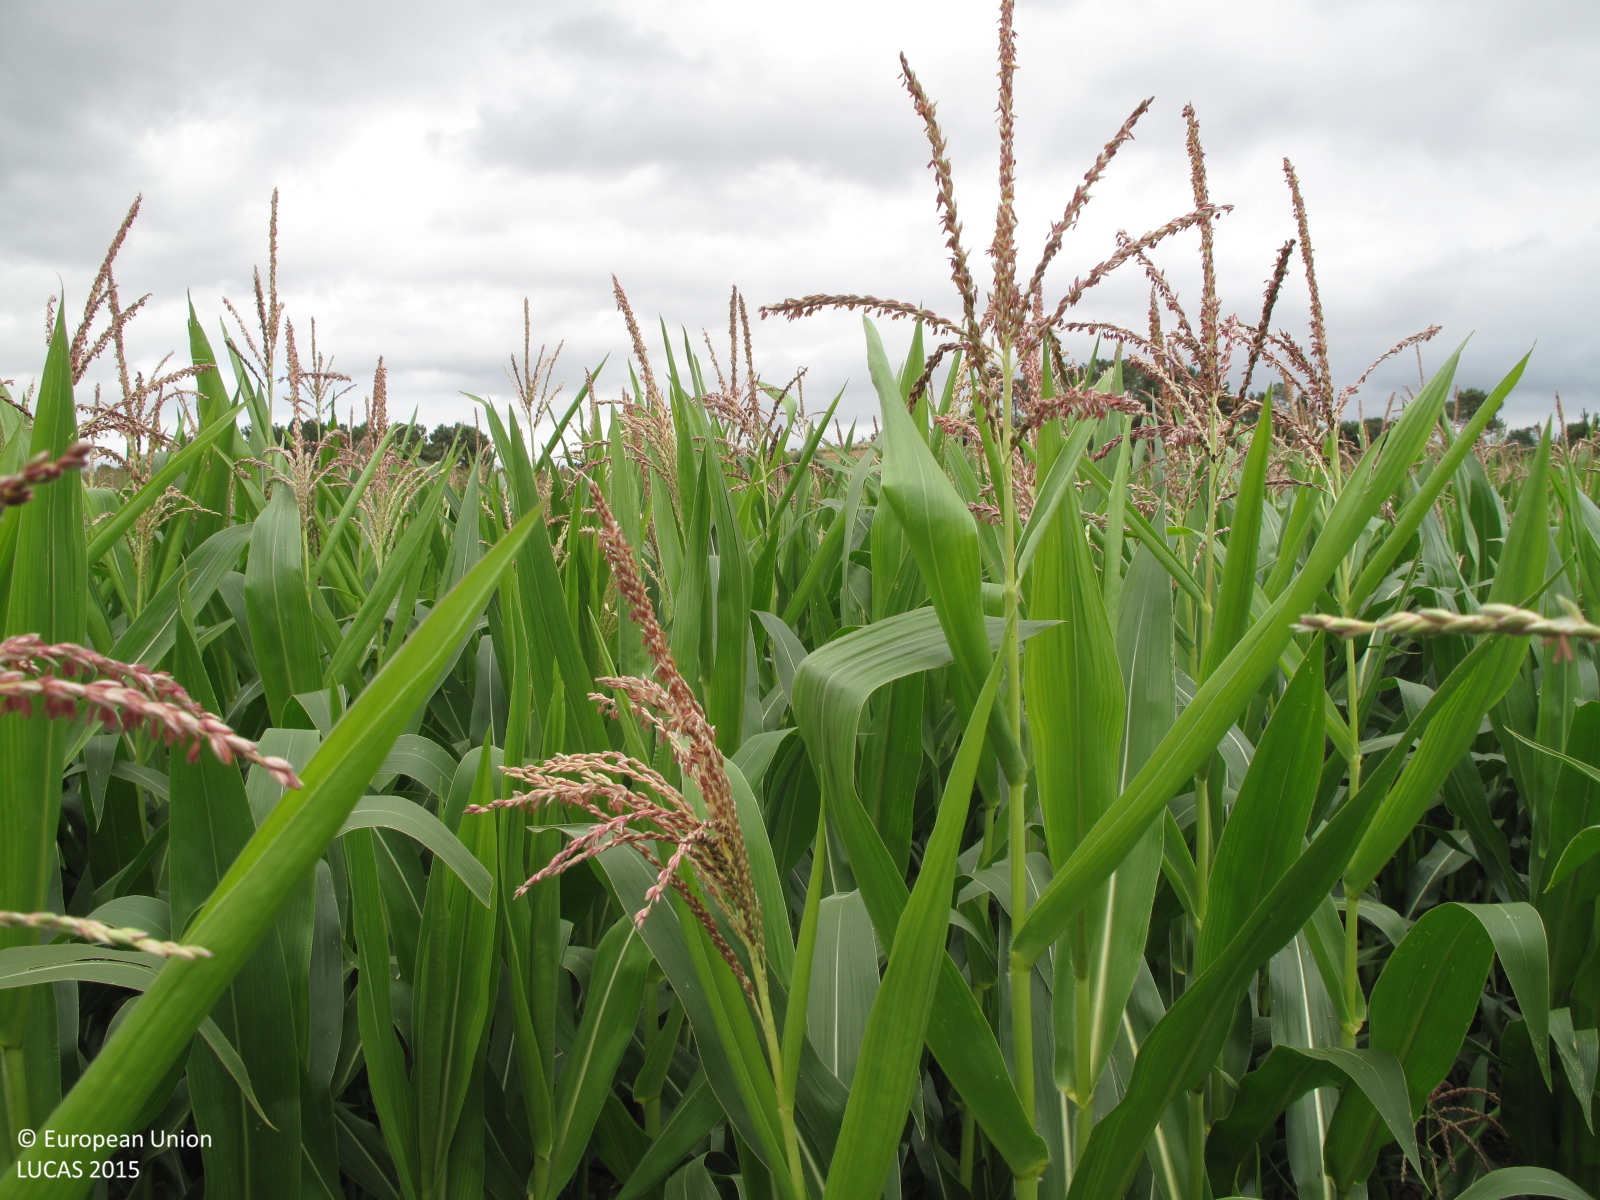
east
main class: Cropland
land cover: Maize
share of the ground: > 75 %
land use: Agriculture (excluding fallow land and kitchen gardens)
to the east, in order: Maize; Grass margins; Maize; Grassland without tree/shrub cover; Fences; Grassland without tree/shrub cover
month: July
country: ES
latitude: 42.9156
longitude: -8.4655
